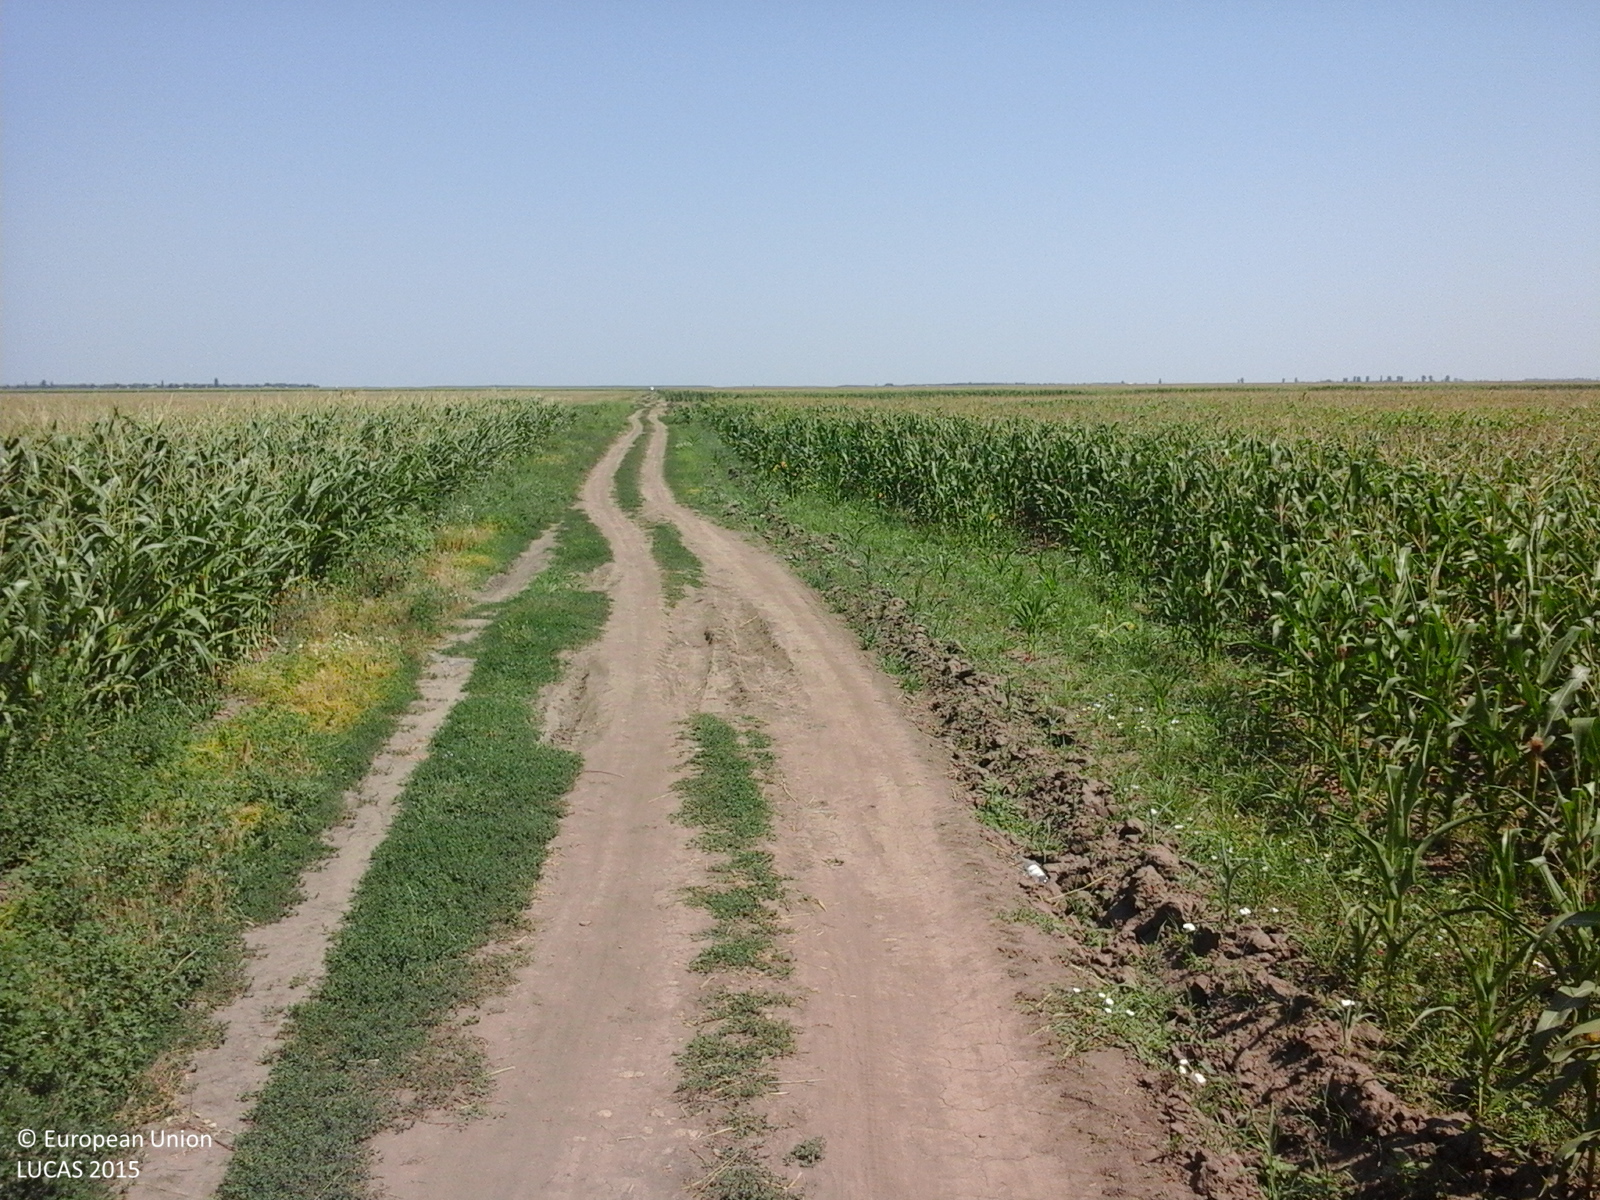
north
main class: Cropland
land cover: Maize
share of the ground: > 75 %
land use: Agriculture (excluding fallow land and kitchen gardens)
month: July
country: RO
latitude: 45.0167
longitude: 27.2076
